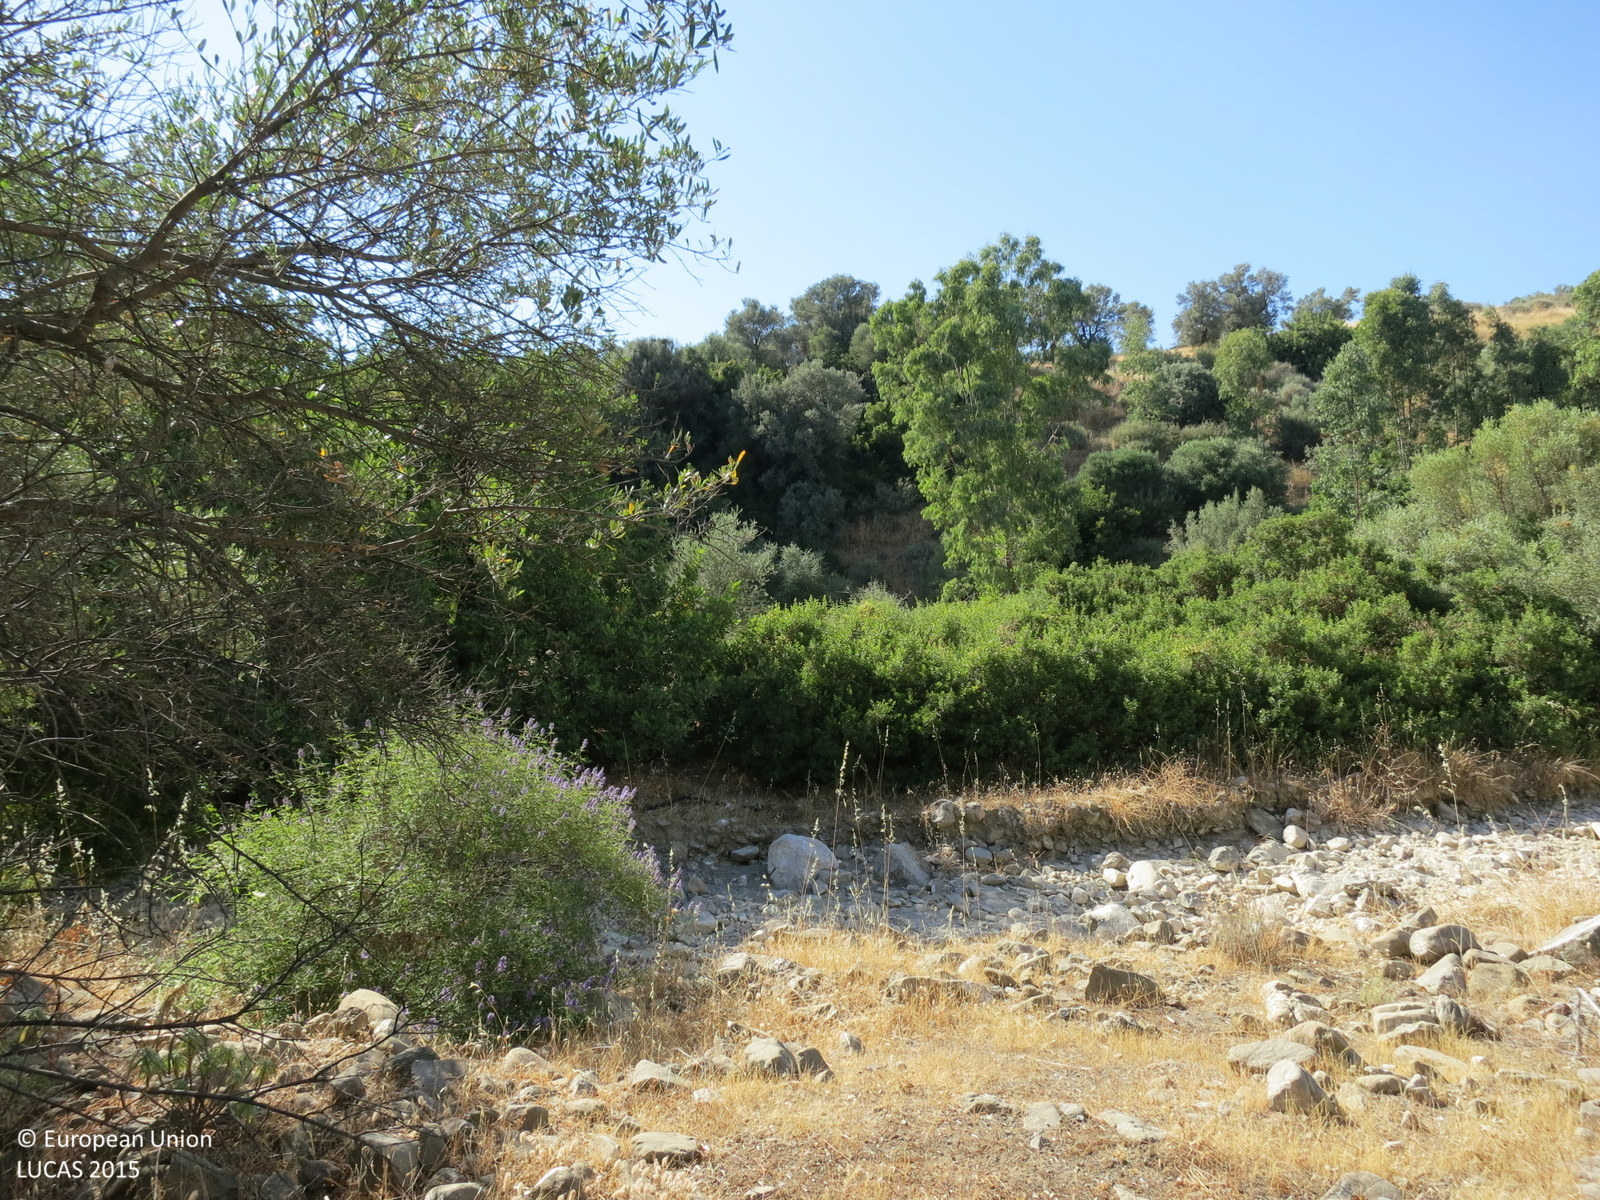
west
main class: Cropland
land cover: Olive groves
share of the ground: 50 - 75 %
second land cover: Shrubland without tree cover
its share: 25 - 50 %
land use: Agriculture (excluding fallow land and kitchen gardens)
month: June
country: GR
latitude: 35.1078
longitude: 24.8073
